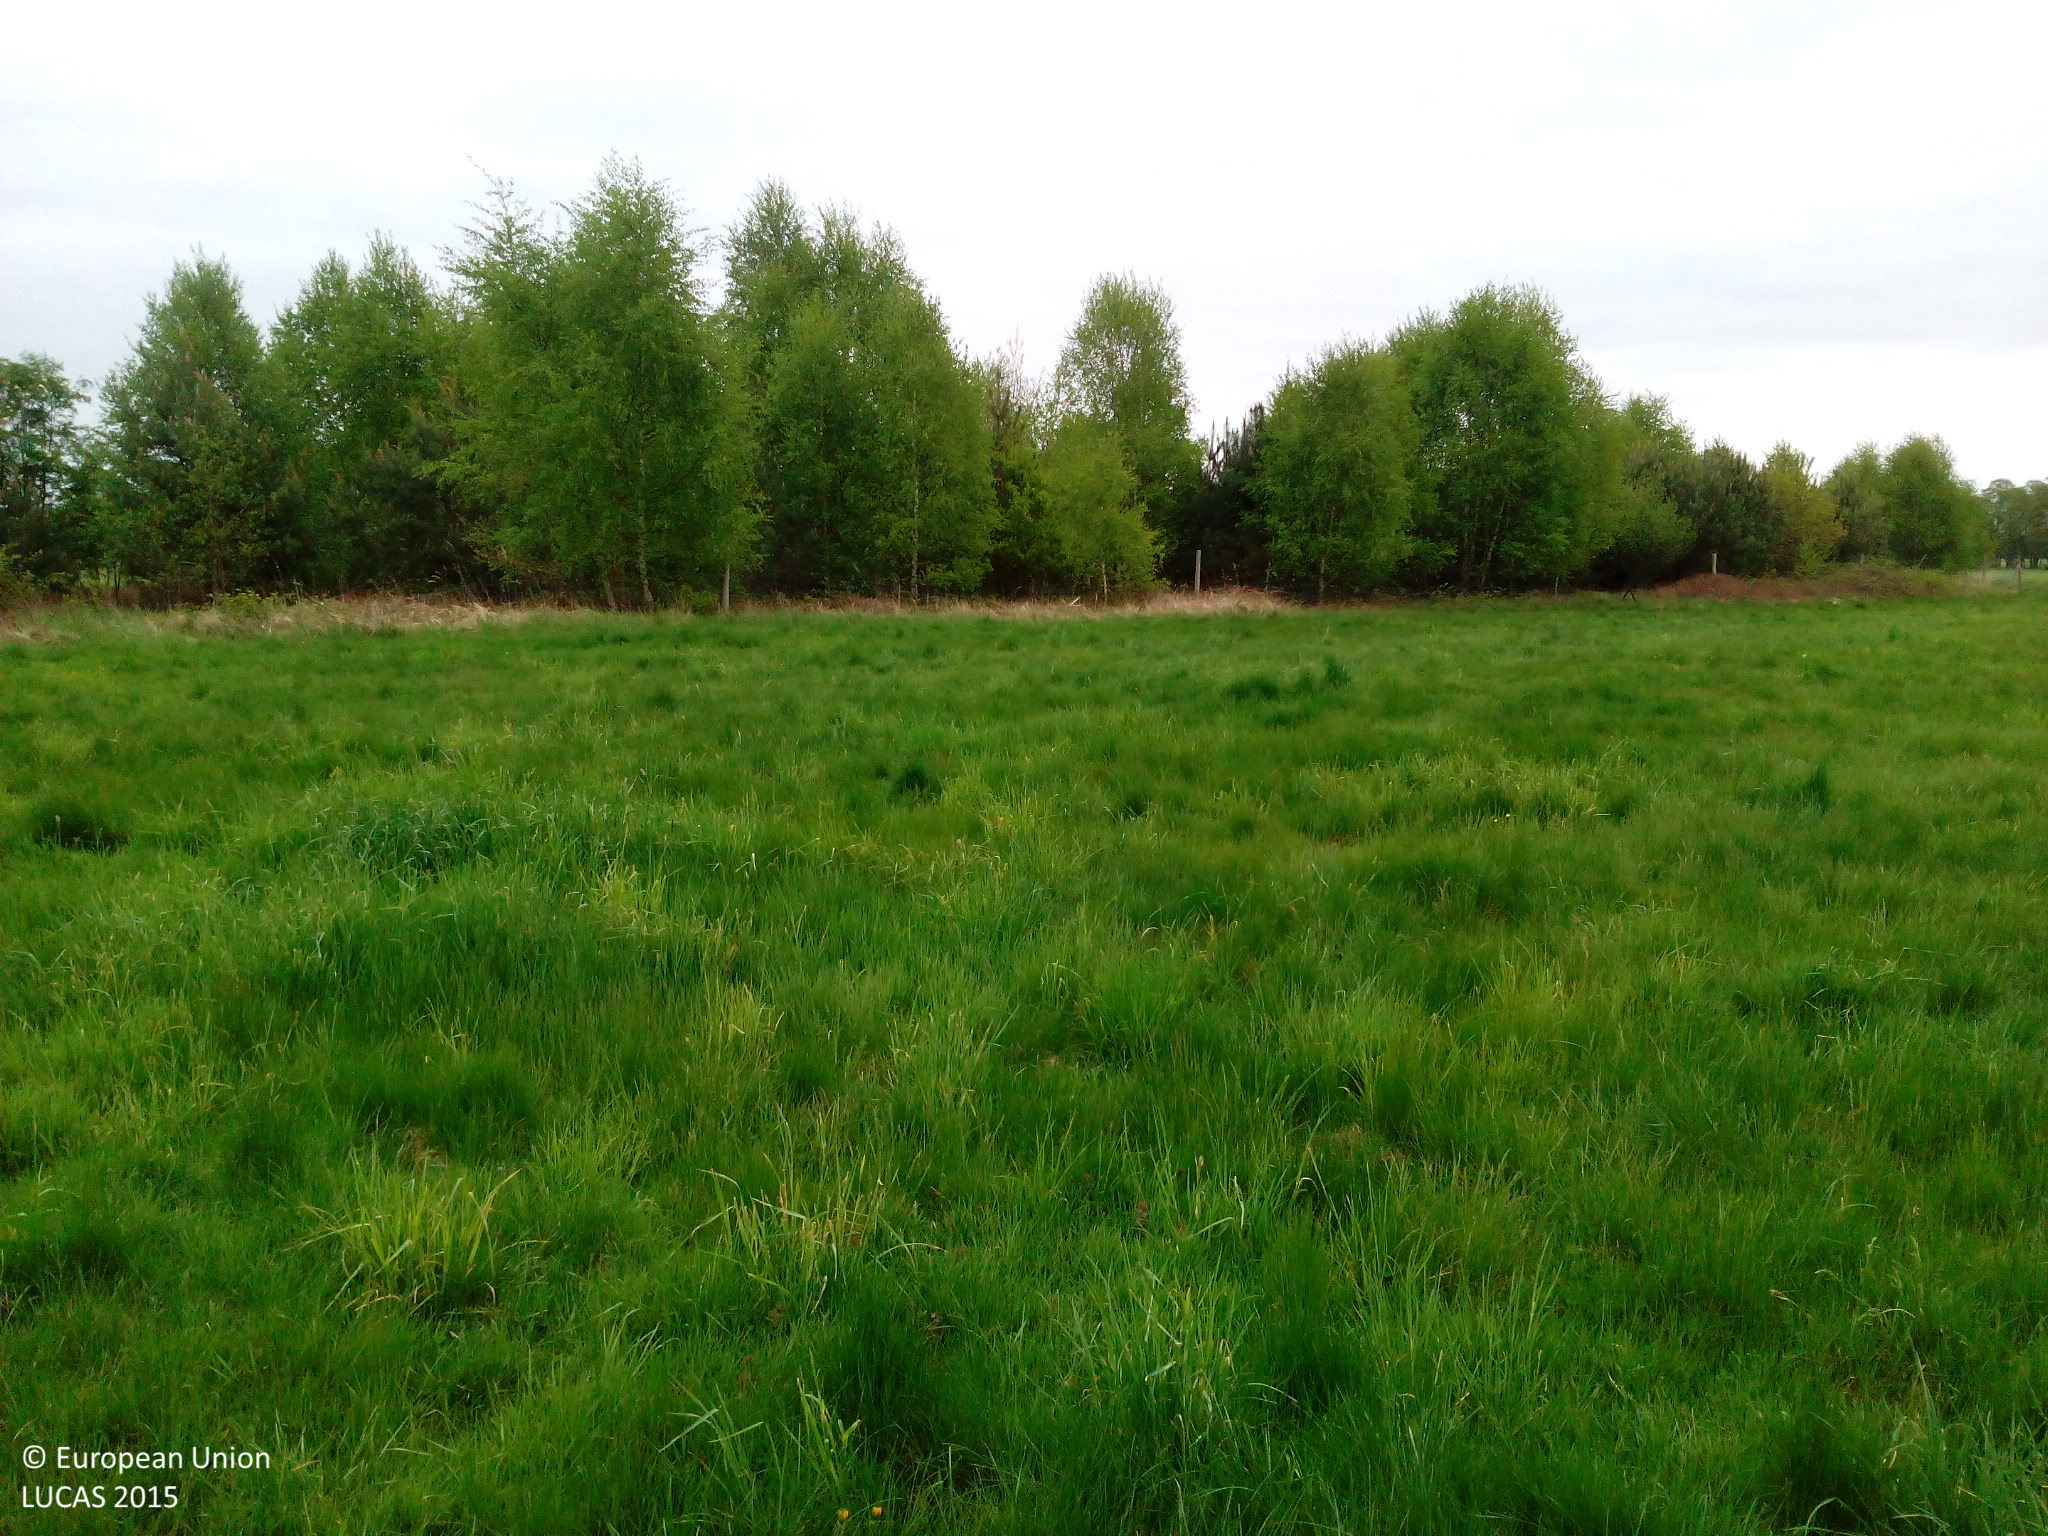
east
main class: Grassland
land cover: Grassland without tree/shrub cover
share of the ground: > 75 %
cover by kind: herbaceous plants 100 %
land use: Agriculture (excluding fallow land and kitchen gardens)
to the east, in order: Grassland without tree/shrub cover; Fences; Pine dominated mixed woodland; Fences; Grassland without tree/shrub cover; Ditches and canals; Grassland without tree/shrub cover
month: May
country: DE
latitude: 52.9256
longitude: 11.4721
